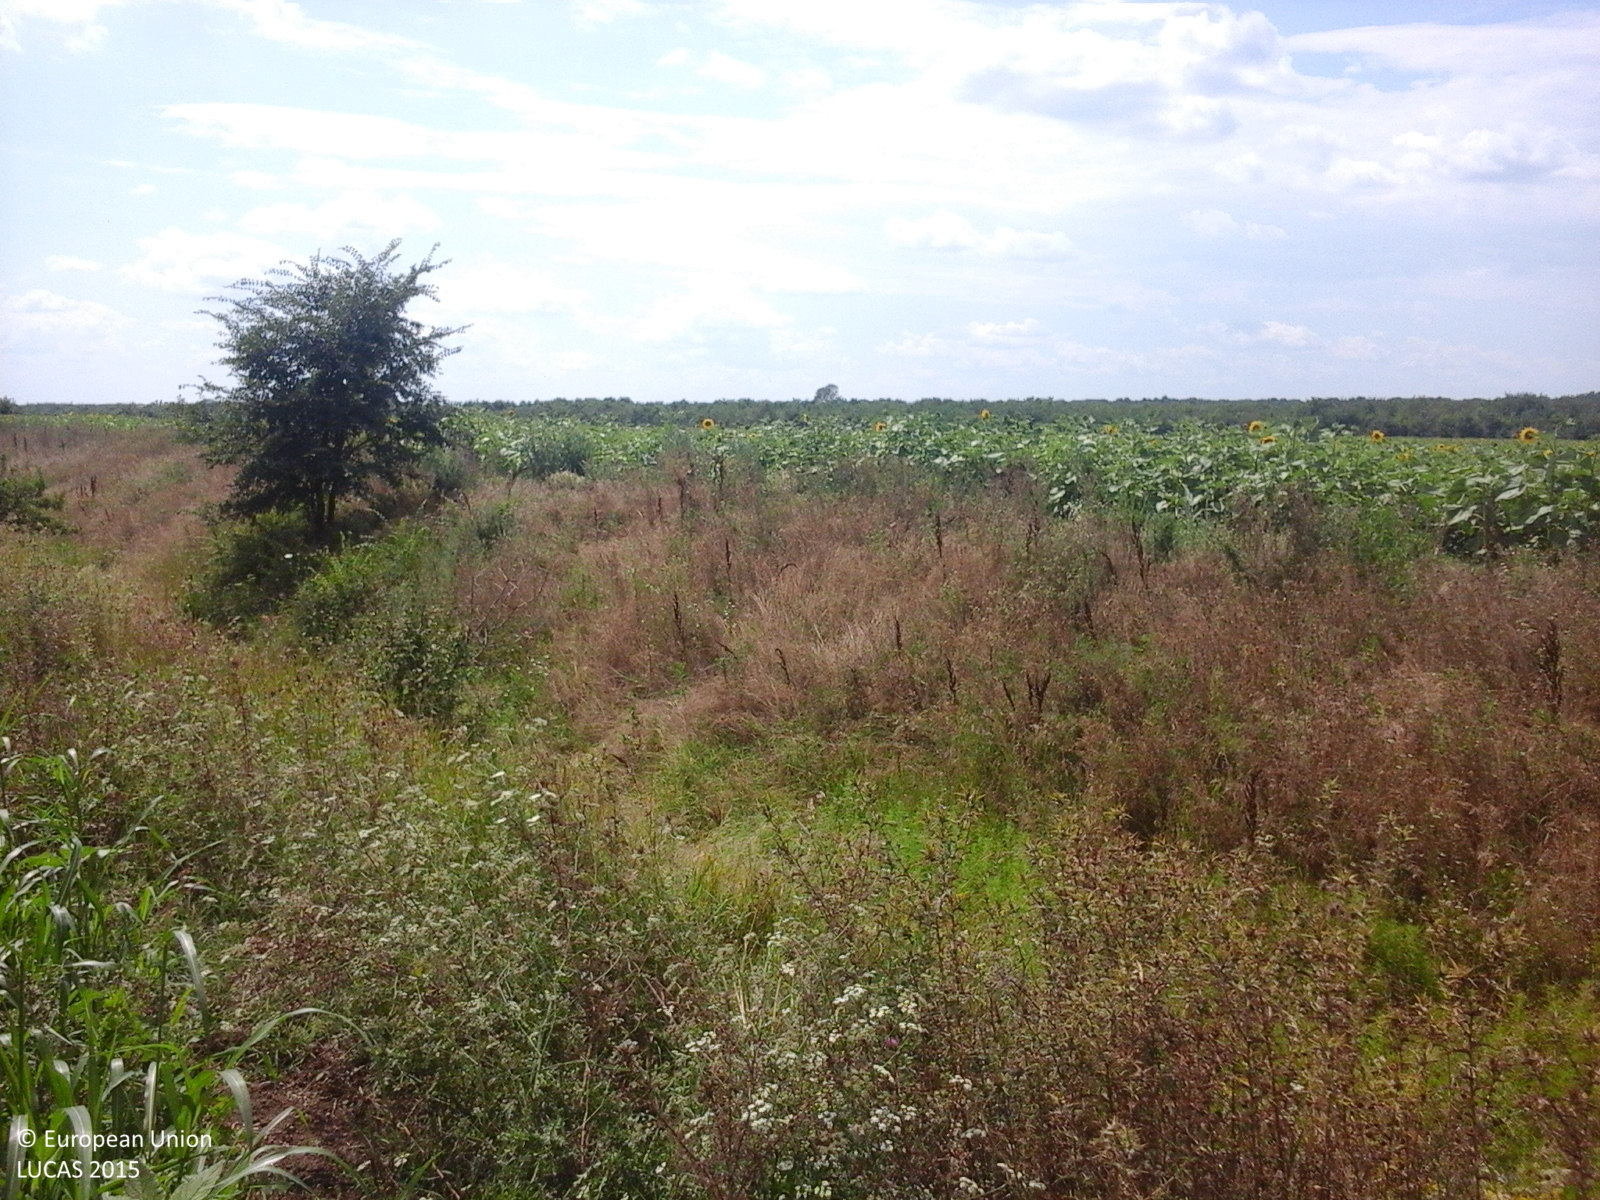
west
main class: Cropland
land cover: Sunflower
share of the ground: > 75 %
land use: Agriculture (excluding fallow land and kitchen gardens)
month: July
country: RO
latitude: 44.0213
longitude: 24.6278
